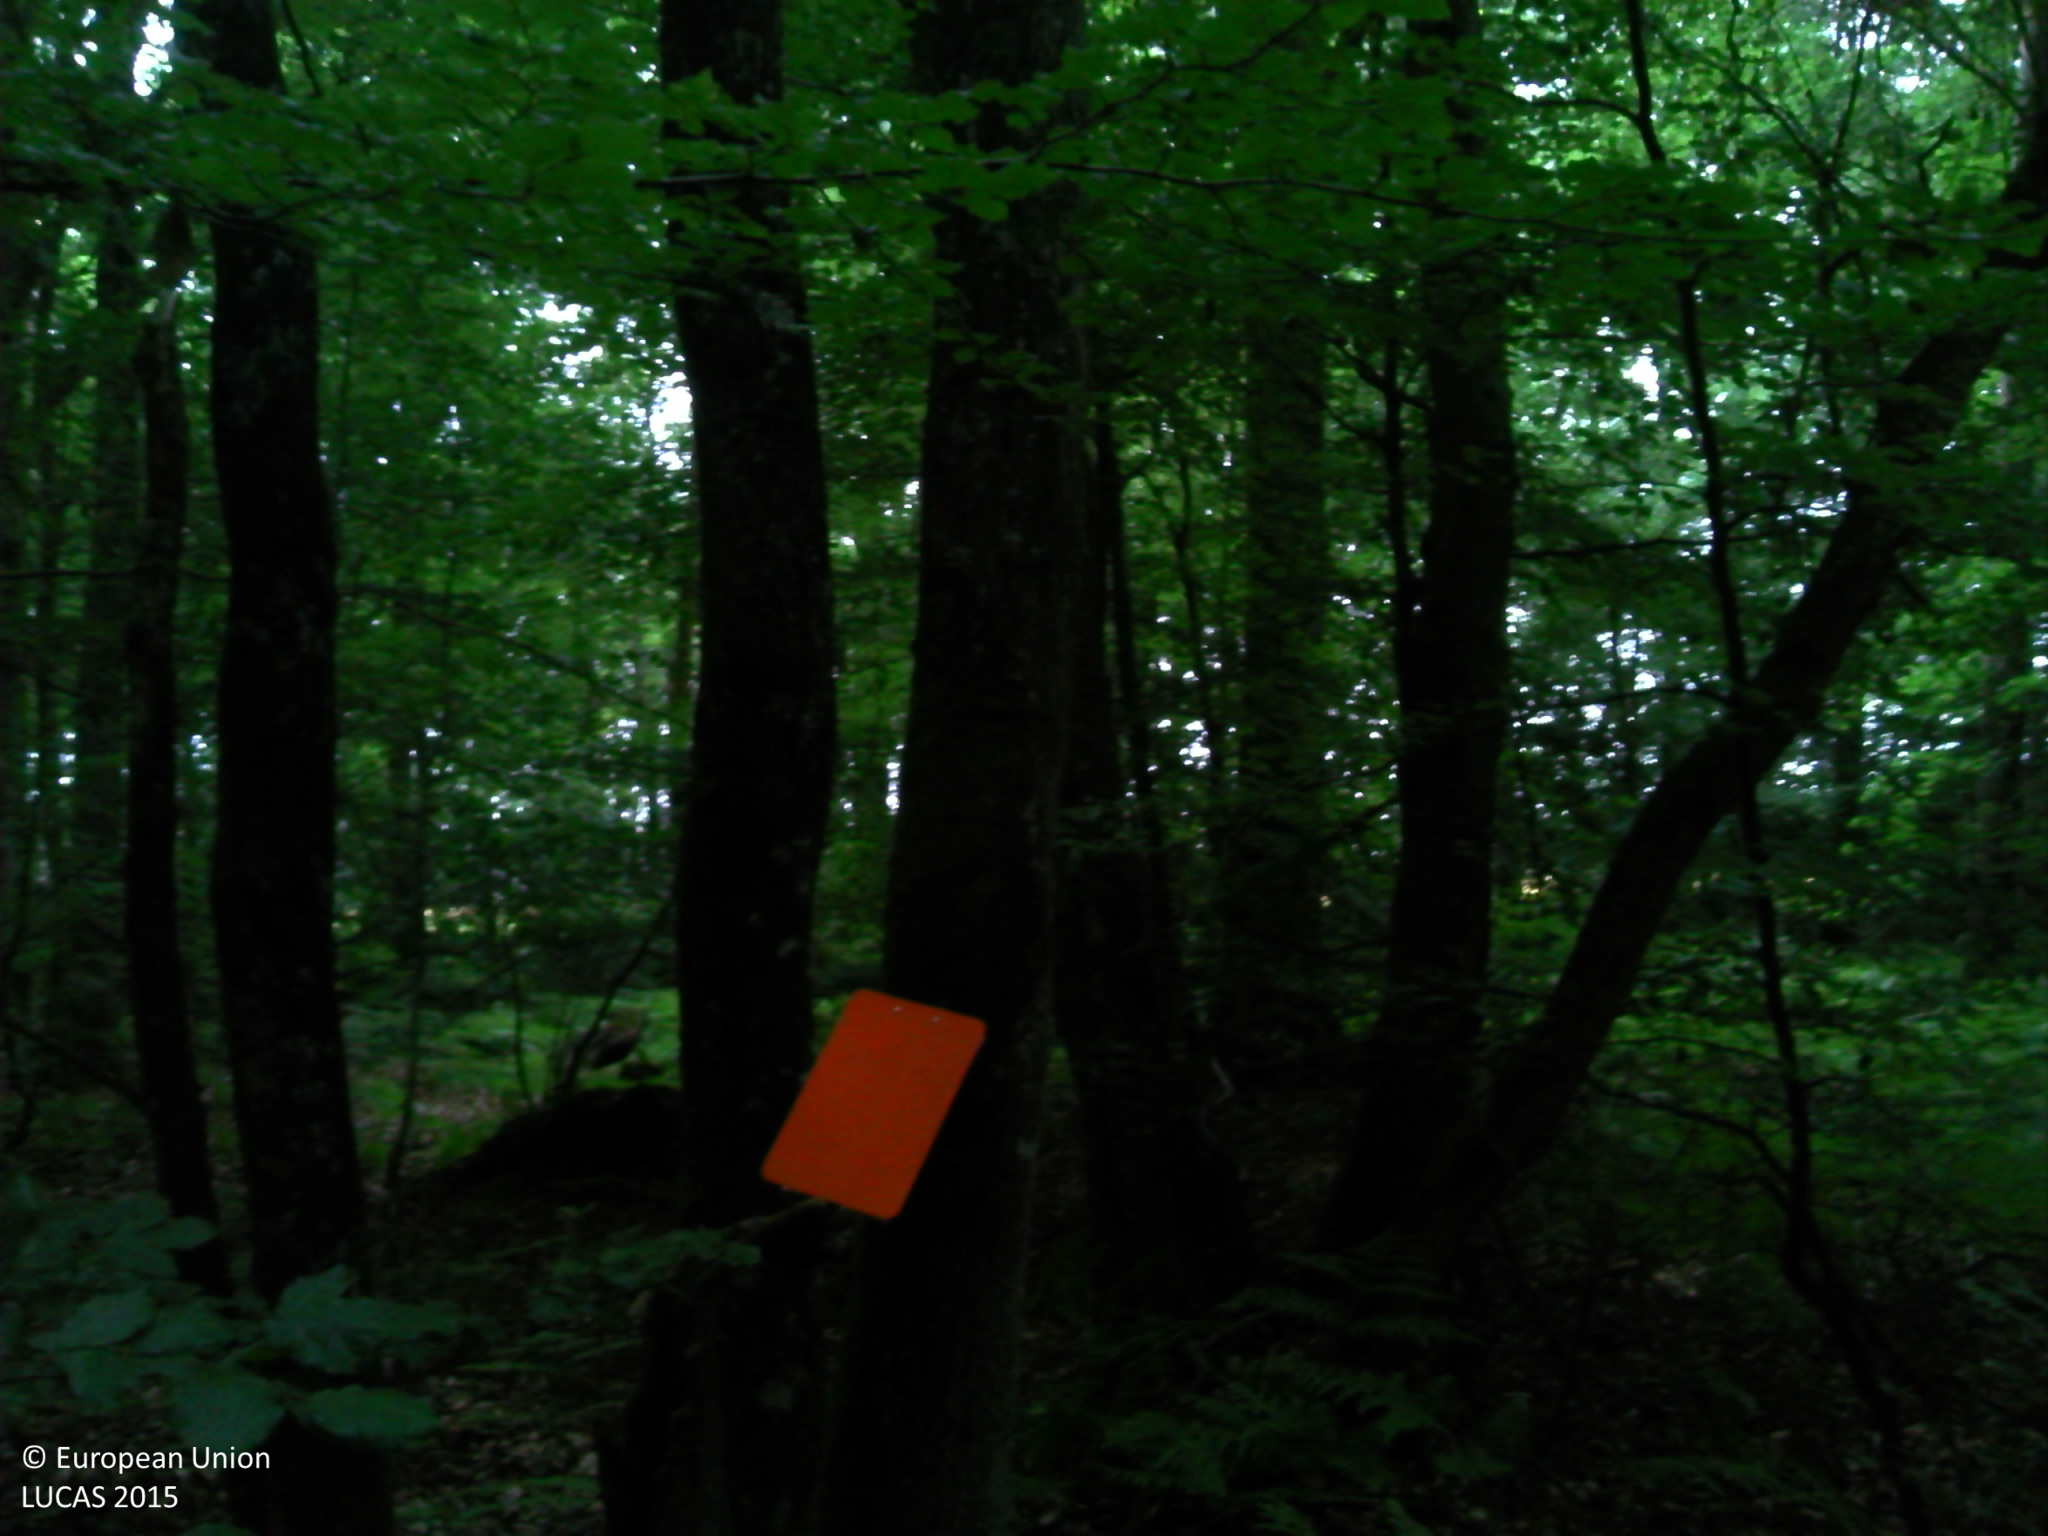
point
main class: Woodland
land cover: Broadleaved woodland
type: acidophilous oak and oak-birch forest
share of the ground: > 75 %
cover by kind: broadleaved forest trees 95 %, herbaceous plants 5 %
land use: Forestry
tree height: > 5 m
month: July
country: FR
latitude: 48.9228
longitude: -0.2554
